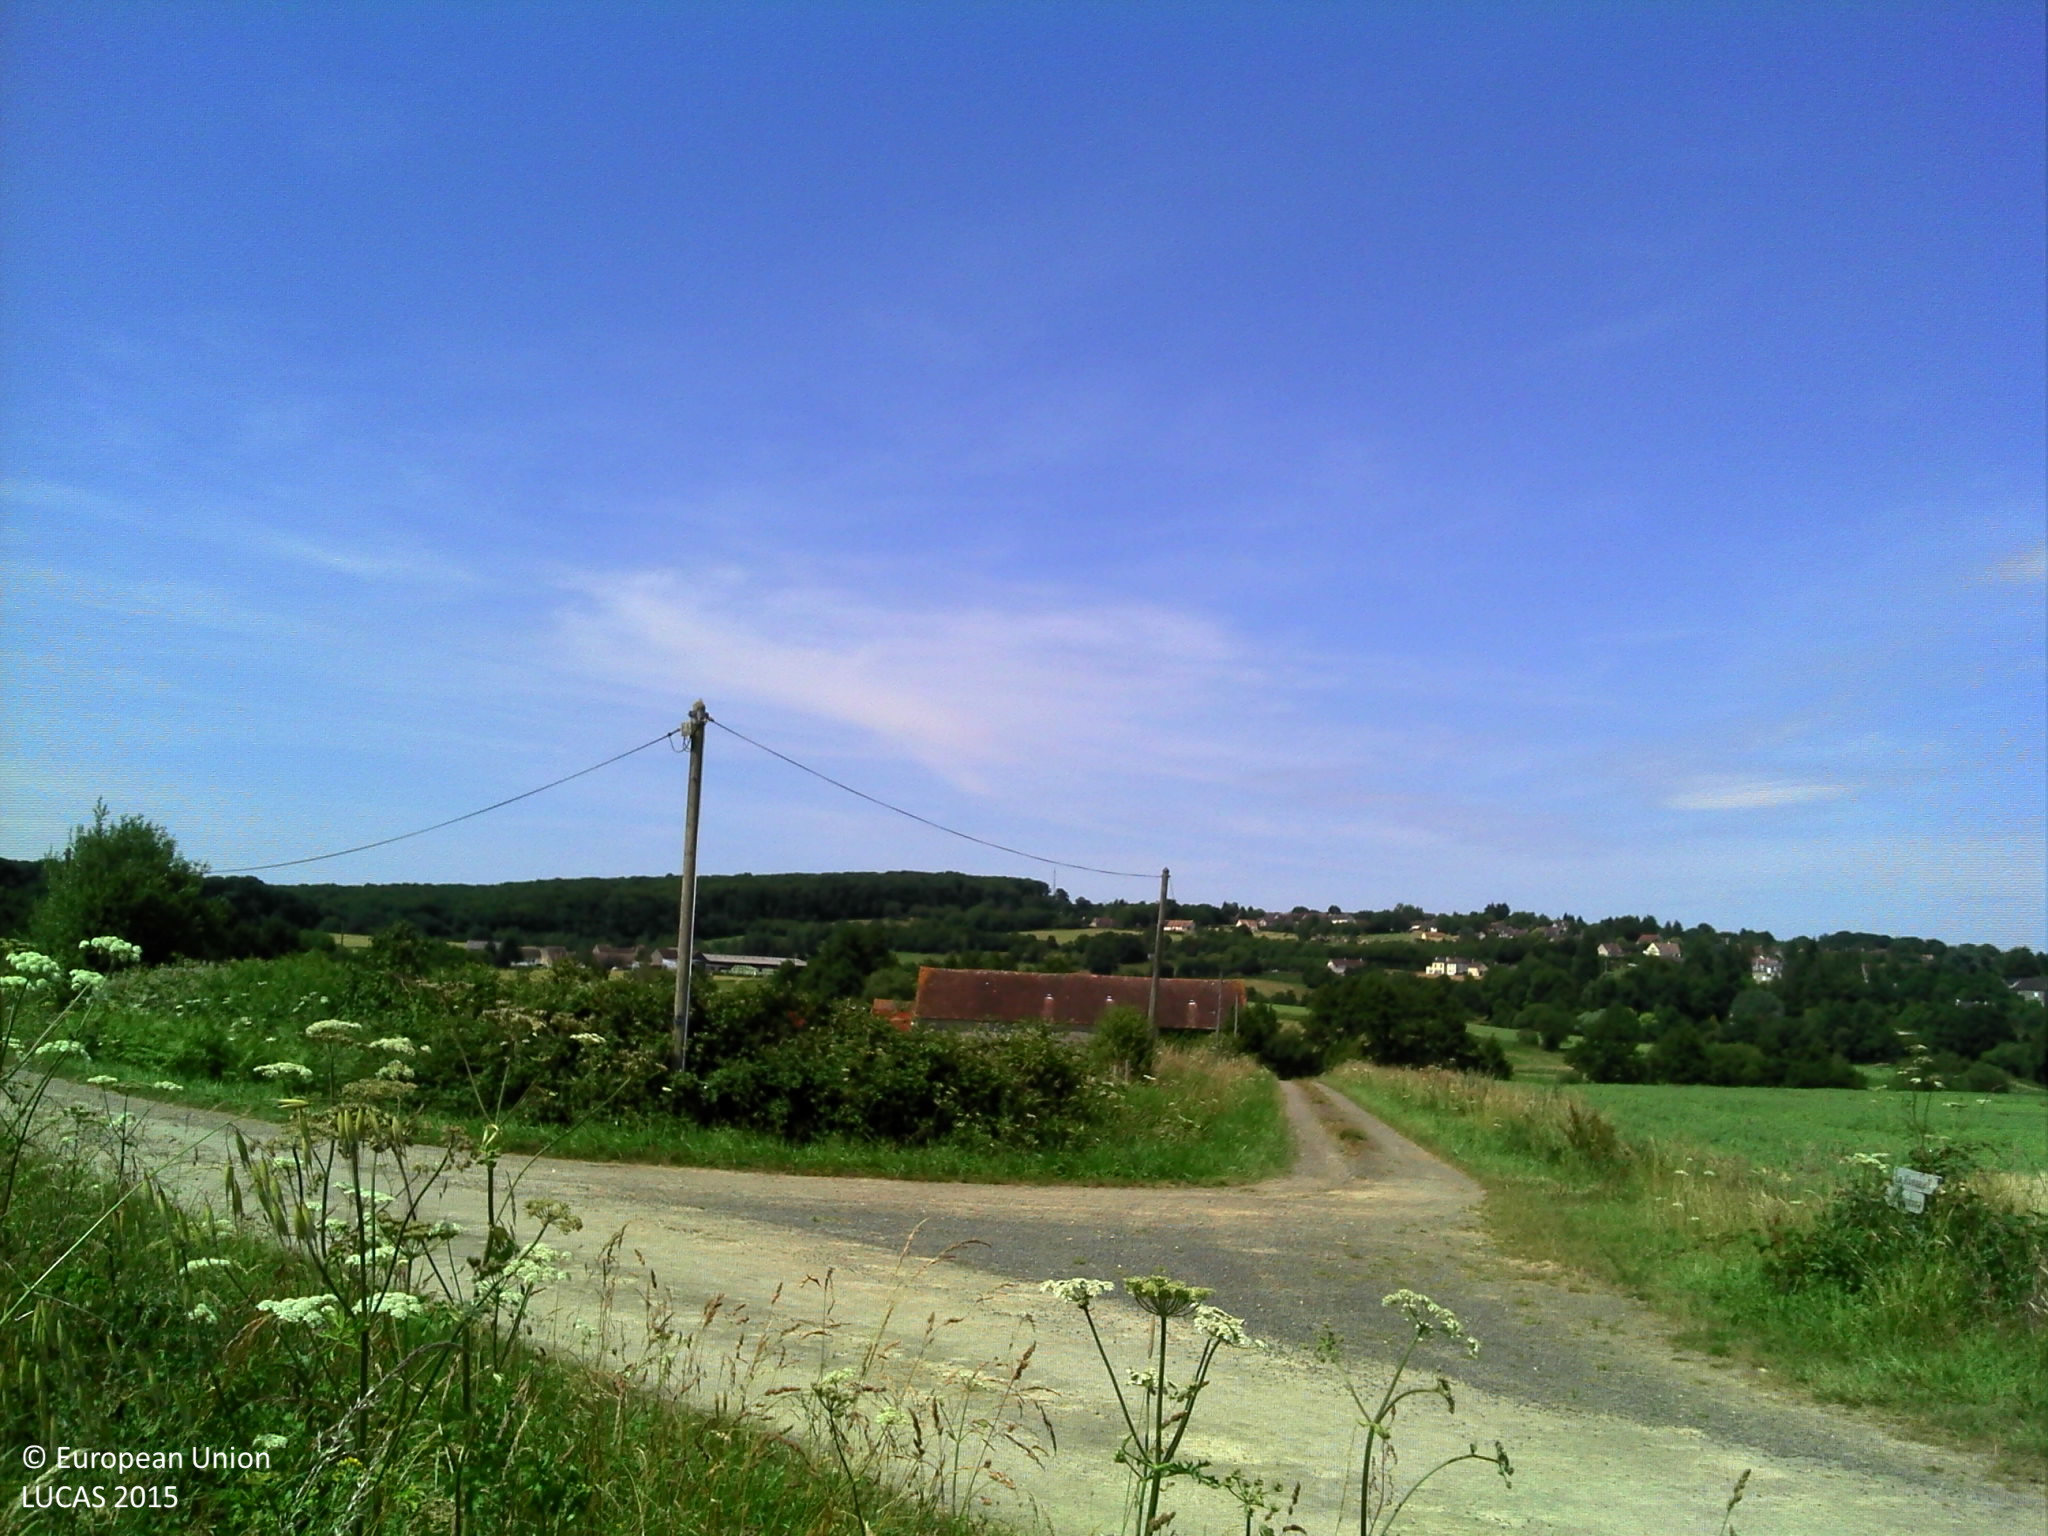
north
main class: Cropland
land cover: Oats
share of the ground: > 75 %
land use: Agriculture (excluding fallow land and kitchen gardens)
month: June
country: FR
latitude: 48.3695
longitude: 0.2403
